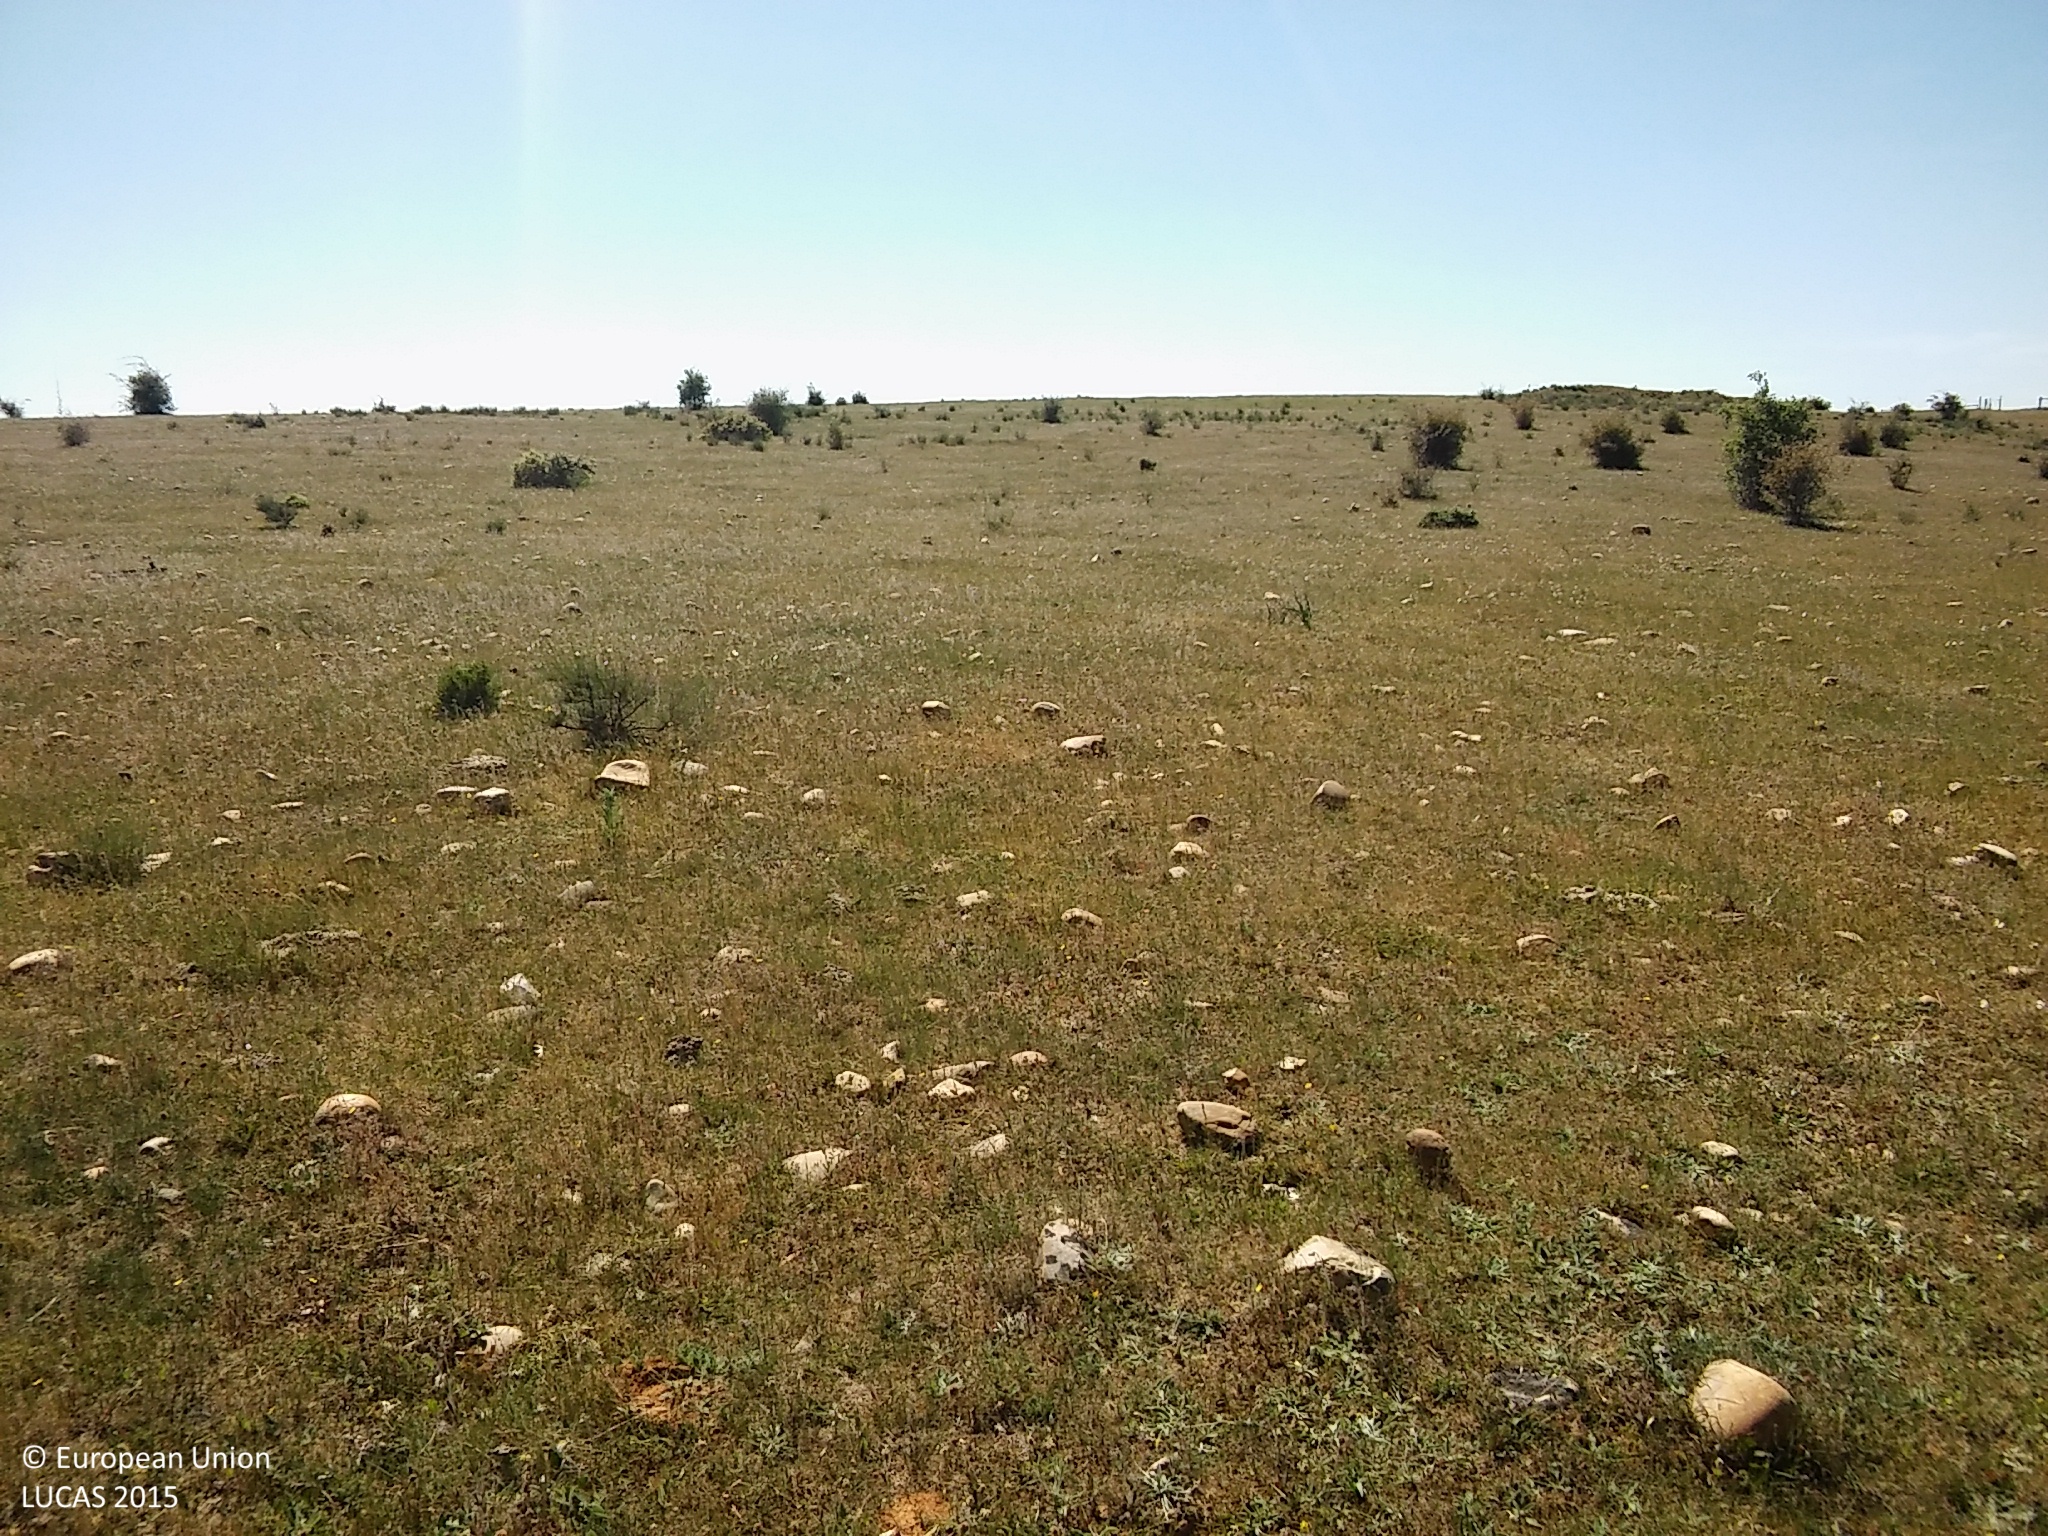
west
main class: Grassland
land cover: Grassland without tree/shrub cover
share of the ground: > 75 %
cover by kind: herbaceous plants 95 %, shrubs 5 %
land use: Agriculture (excluding fallow land and kitchen gardens)
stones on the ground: 10 - 25 %
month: May
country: ES
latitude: 41.4073
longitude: -3.6989
